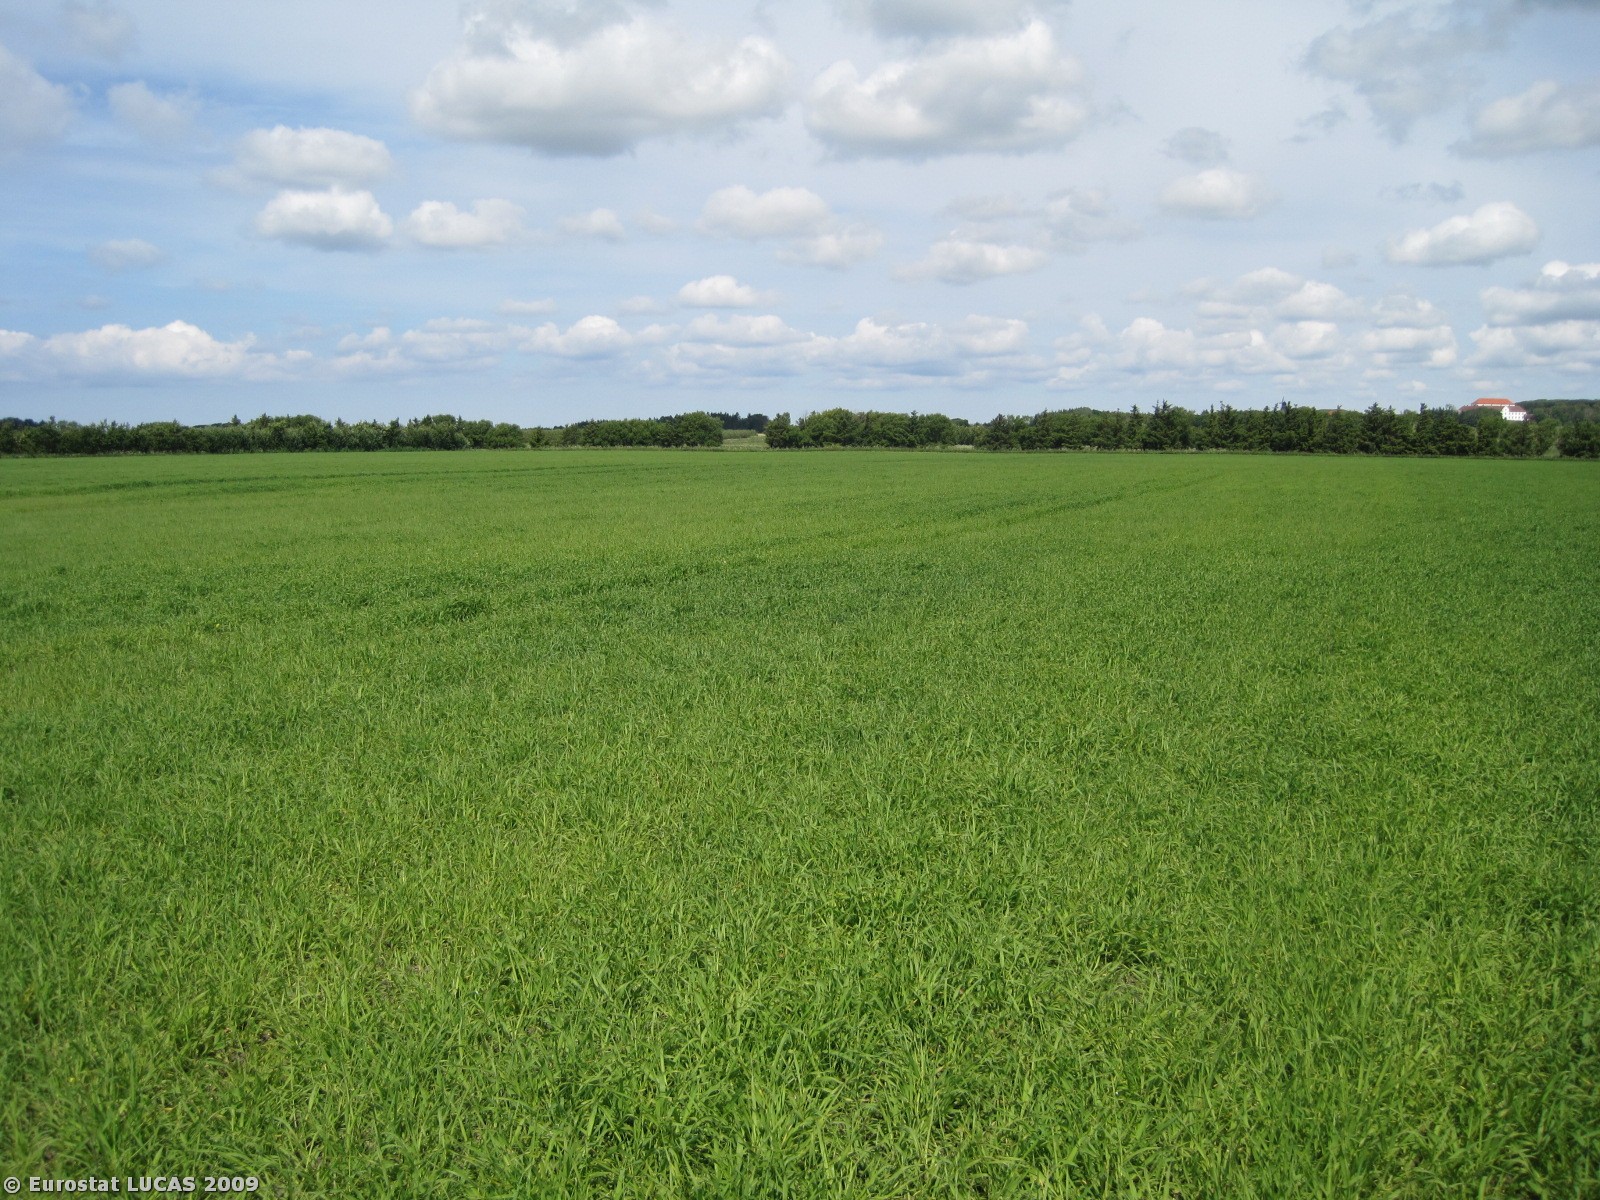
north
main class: Cropland
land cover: Barley
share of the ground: > 75 %
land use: Agriculture (excluding fallow land and kitchen gardens)
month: June
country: DK
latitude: 57.3561
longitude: 9.7843
